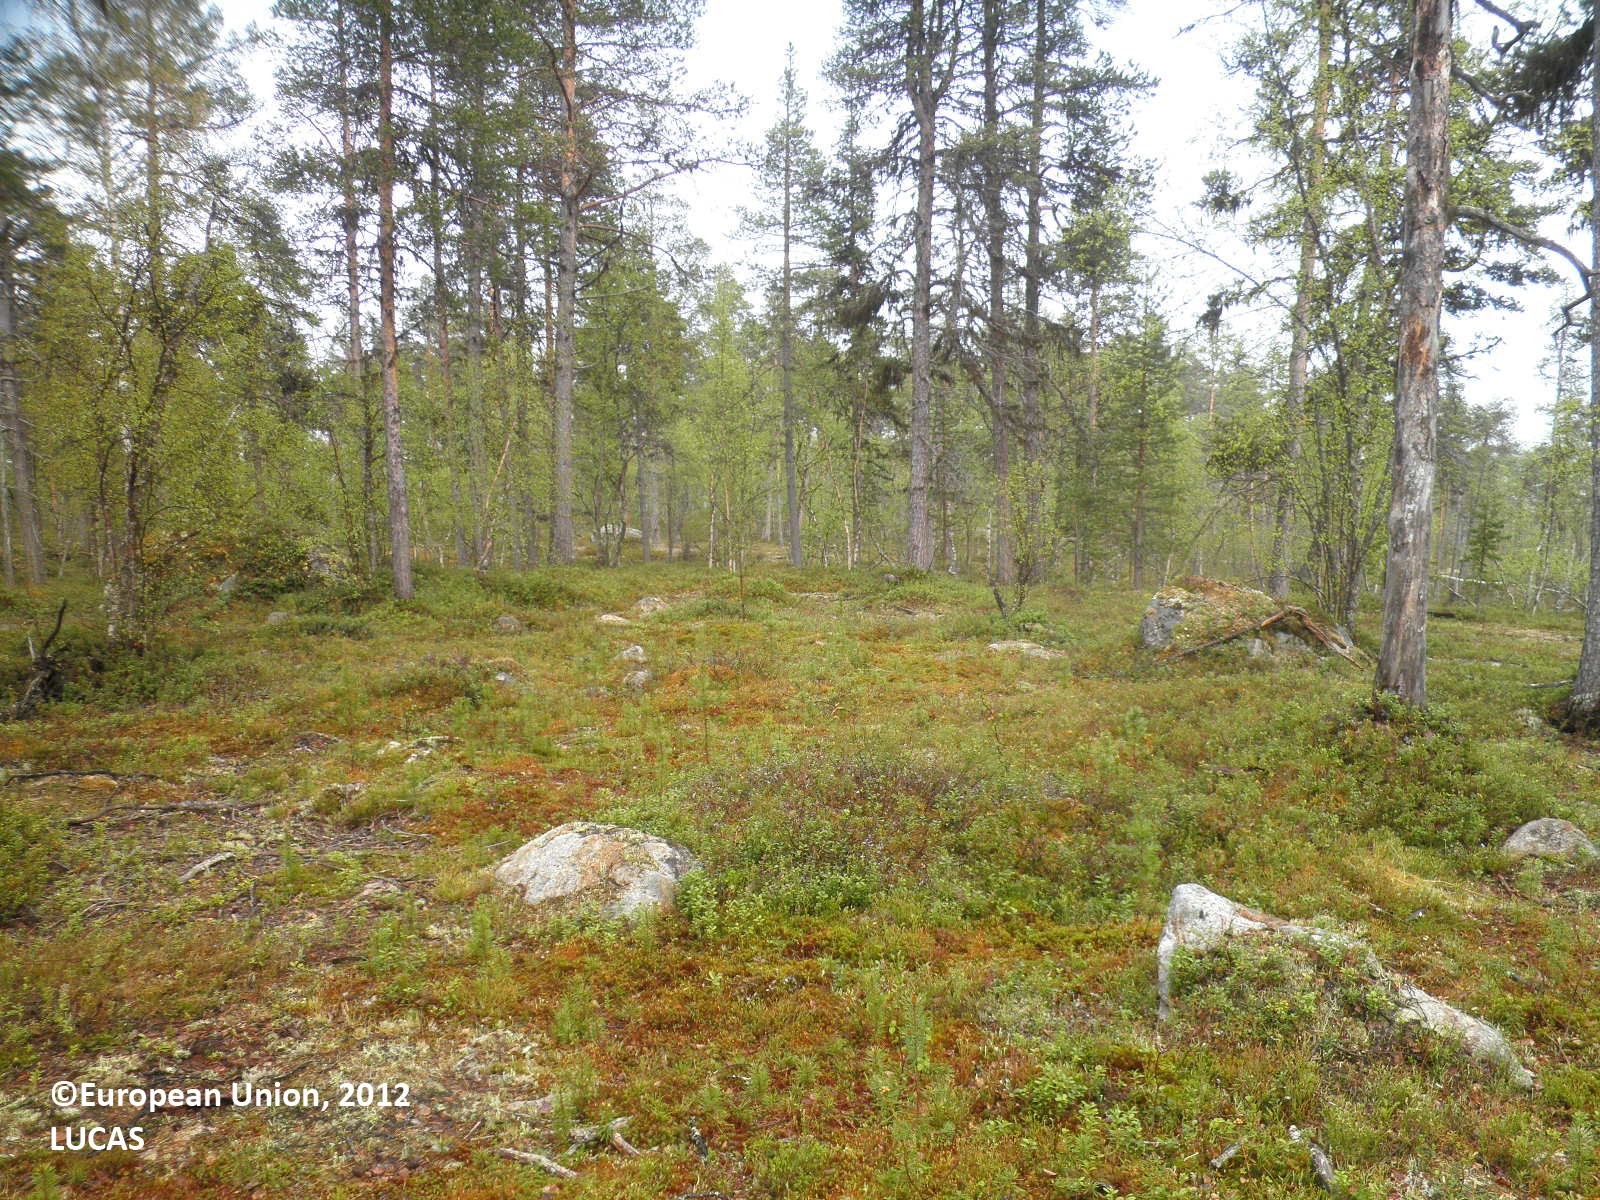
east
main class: Woodland
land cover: Pine dominated mixed woodland
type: boreal forest
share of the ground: 50 - 75 %
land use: Forestry
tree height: > 5 m
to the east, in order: Pine dominated mixed woodland; Inland water bodies
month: June
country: FI
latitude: 69.0504
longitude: 27.1265
